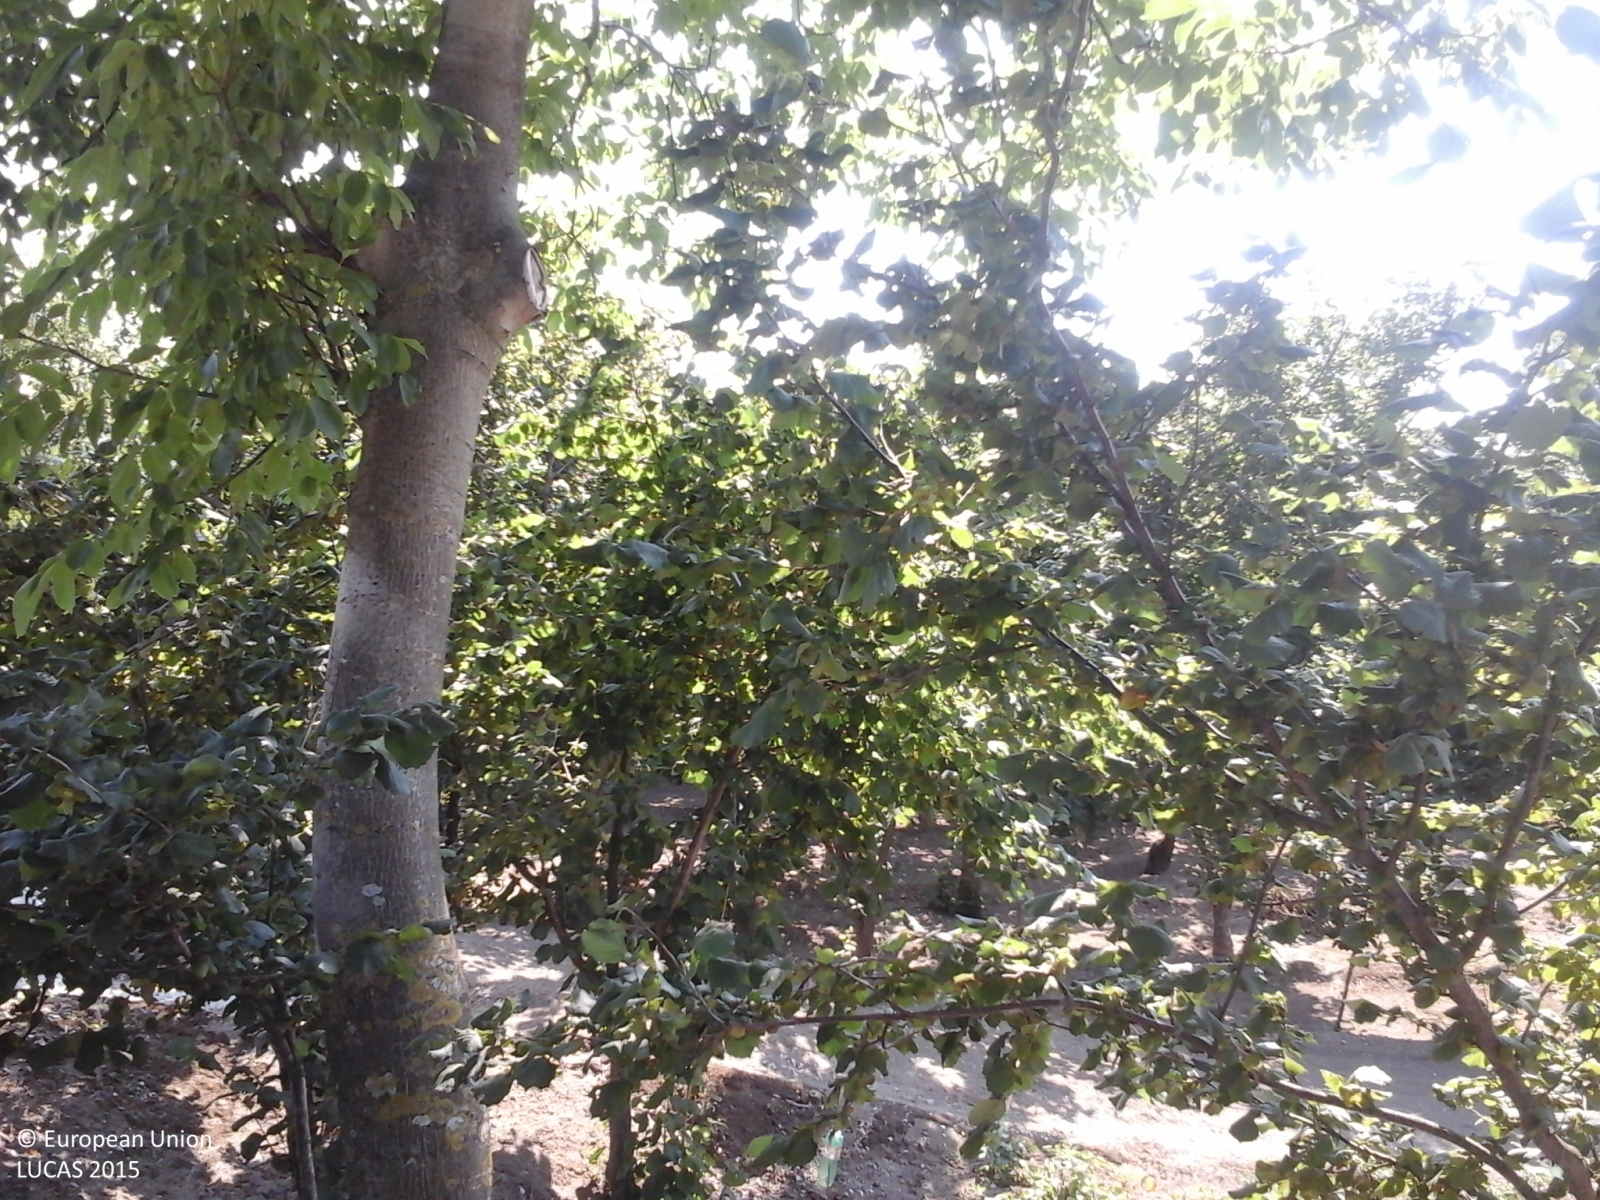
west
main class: Cropland
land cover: Nuts trees
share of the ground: > 75 %
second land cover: Other bare soil
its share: > 75 %
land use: Agriculture (excluding fallow land and kitchen gardens)
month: July
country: IT
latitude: 40.9746
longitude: 14.6045
